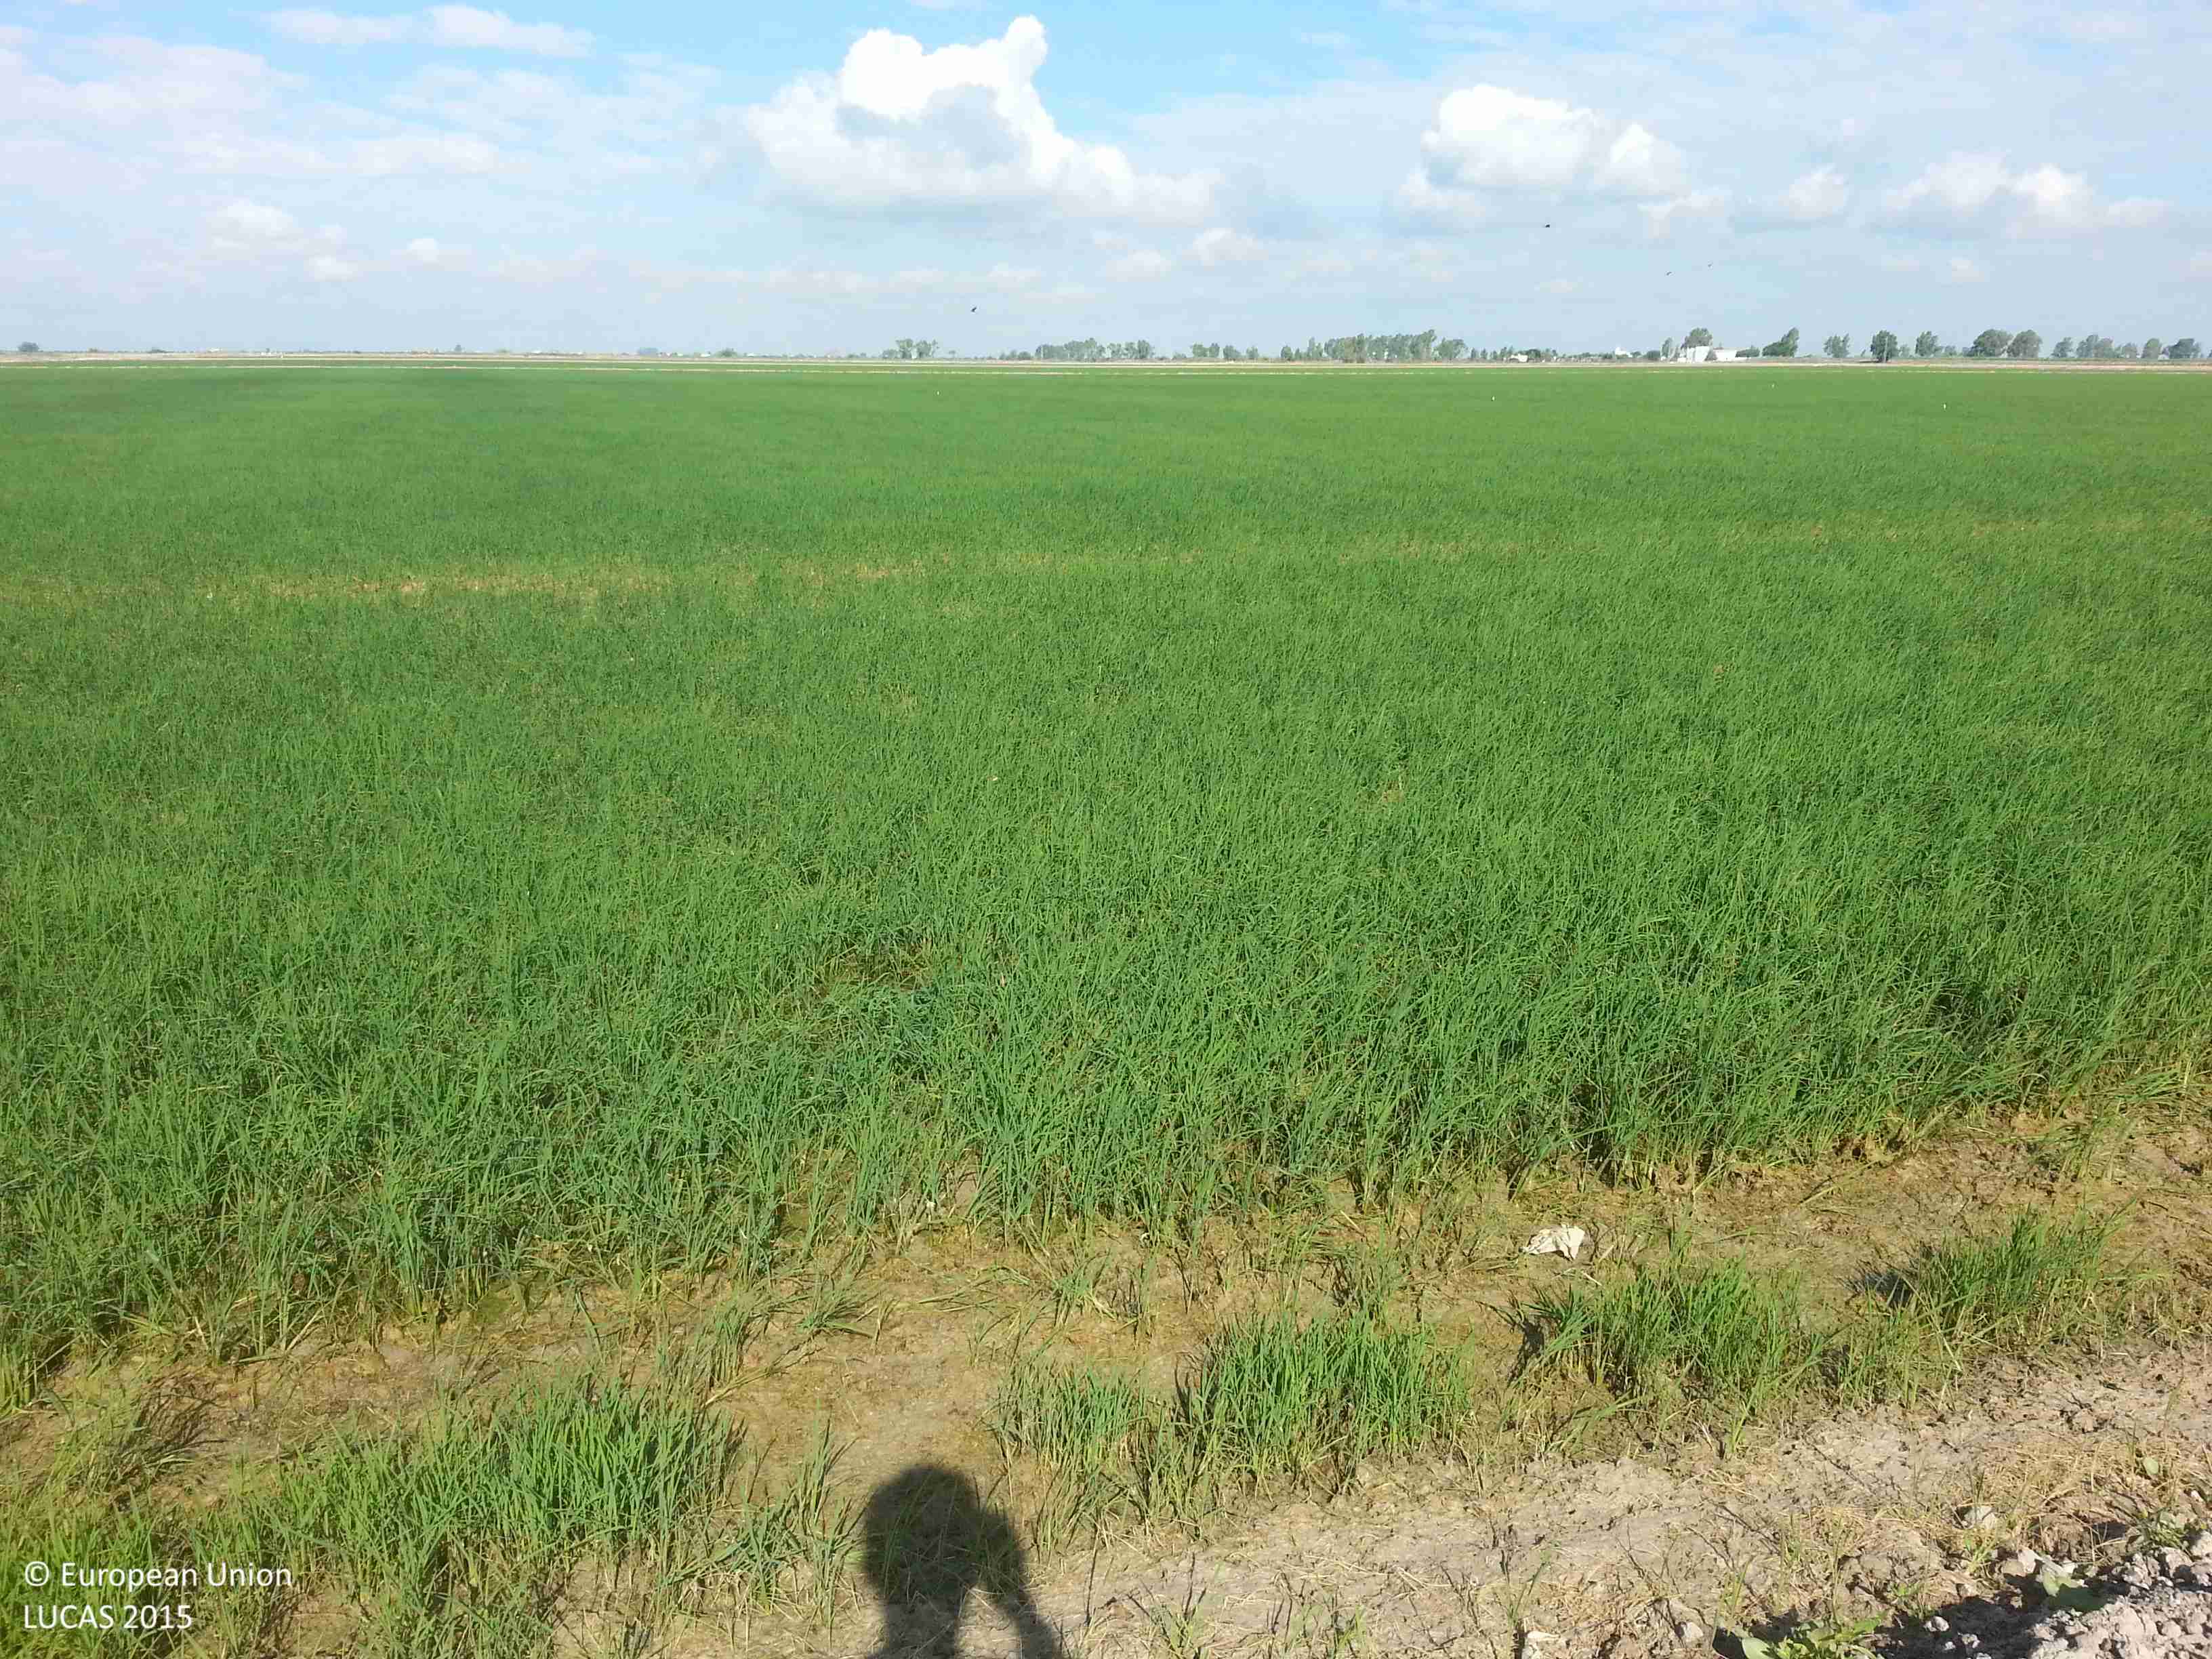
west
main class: Cropland
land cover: Rice
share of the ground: > 75 %
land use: Agriculture (excluding fallow land and kitchen gardens)
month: June
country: ES
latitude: 37.1430
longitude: -6.0859
